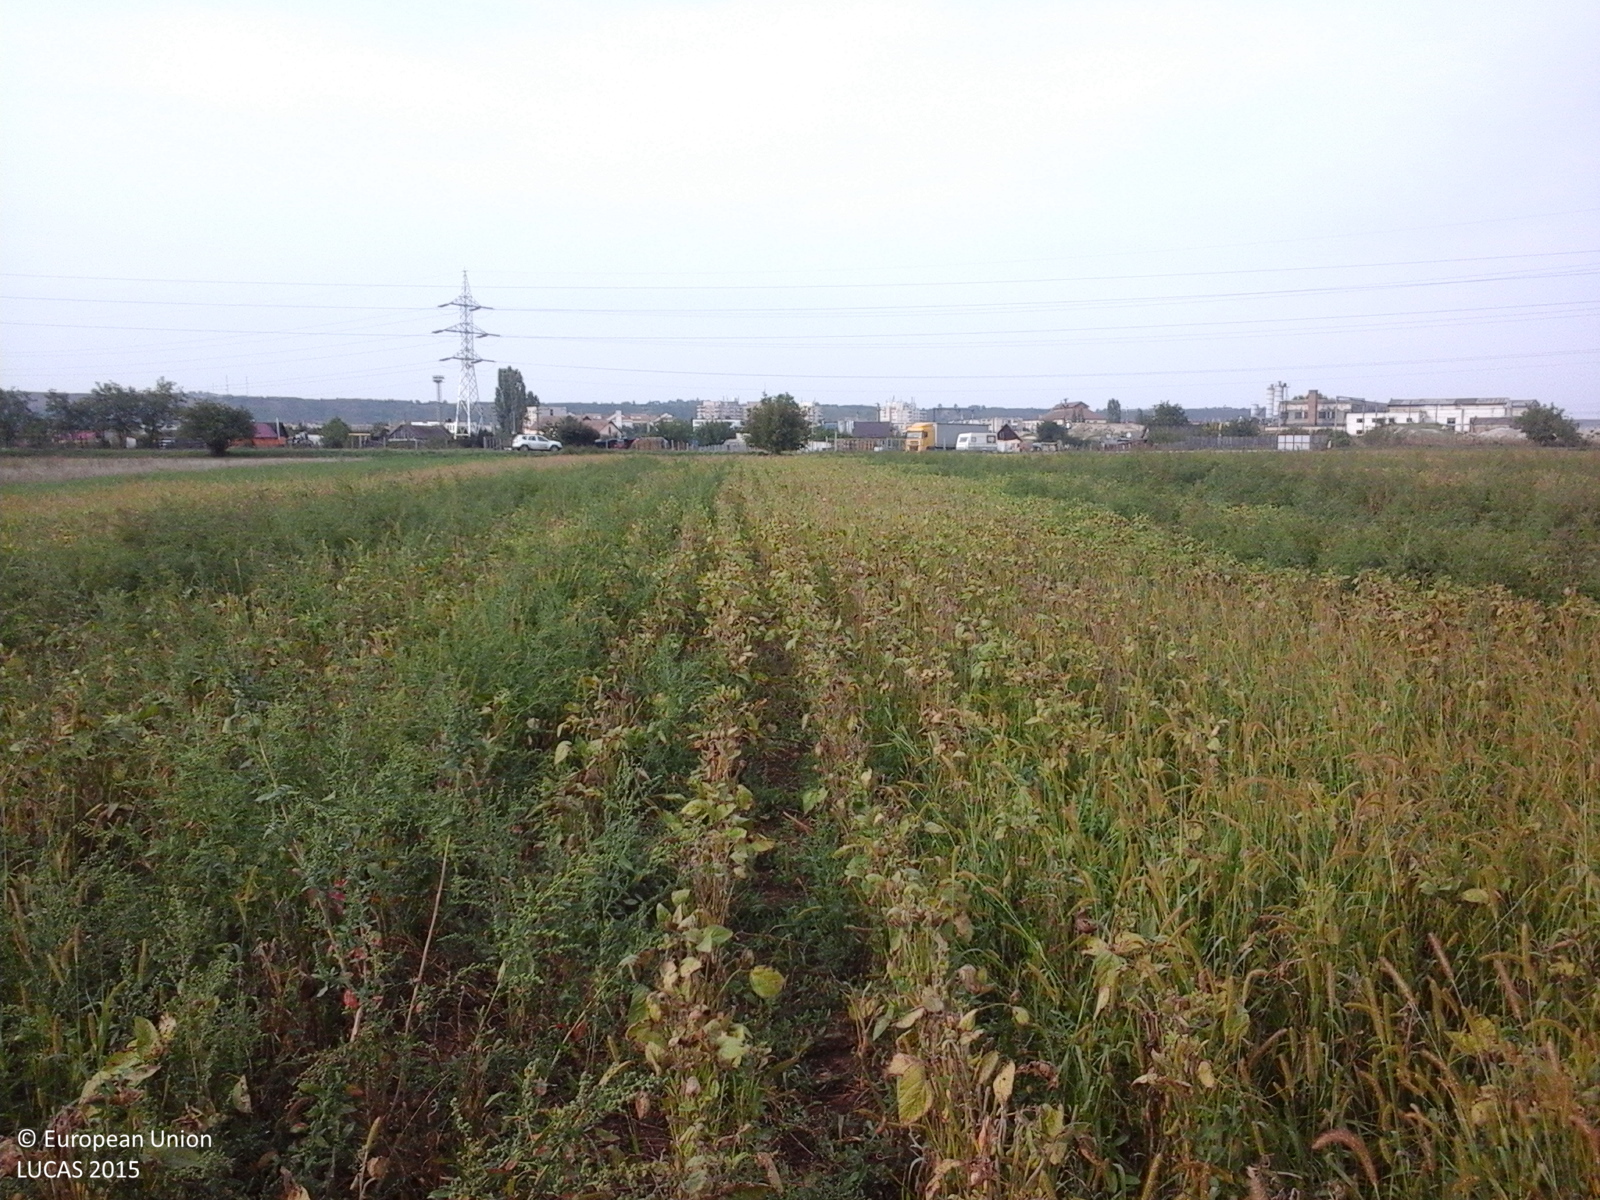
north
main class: Cropland
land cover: Soya
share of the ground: > 75 %
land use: Agriculture (excluding fallow land and kitchen gardens)
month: September
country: RO
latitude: 46.5464
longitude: 23.8061
